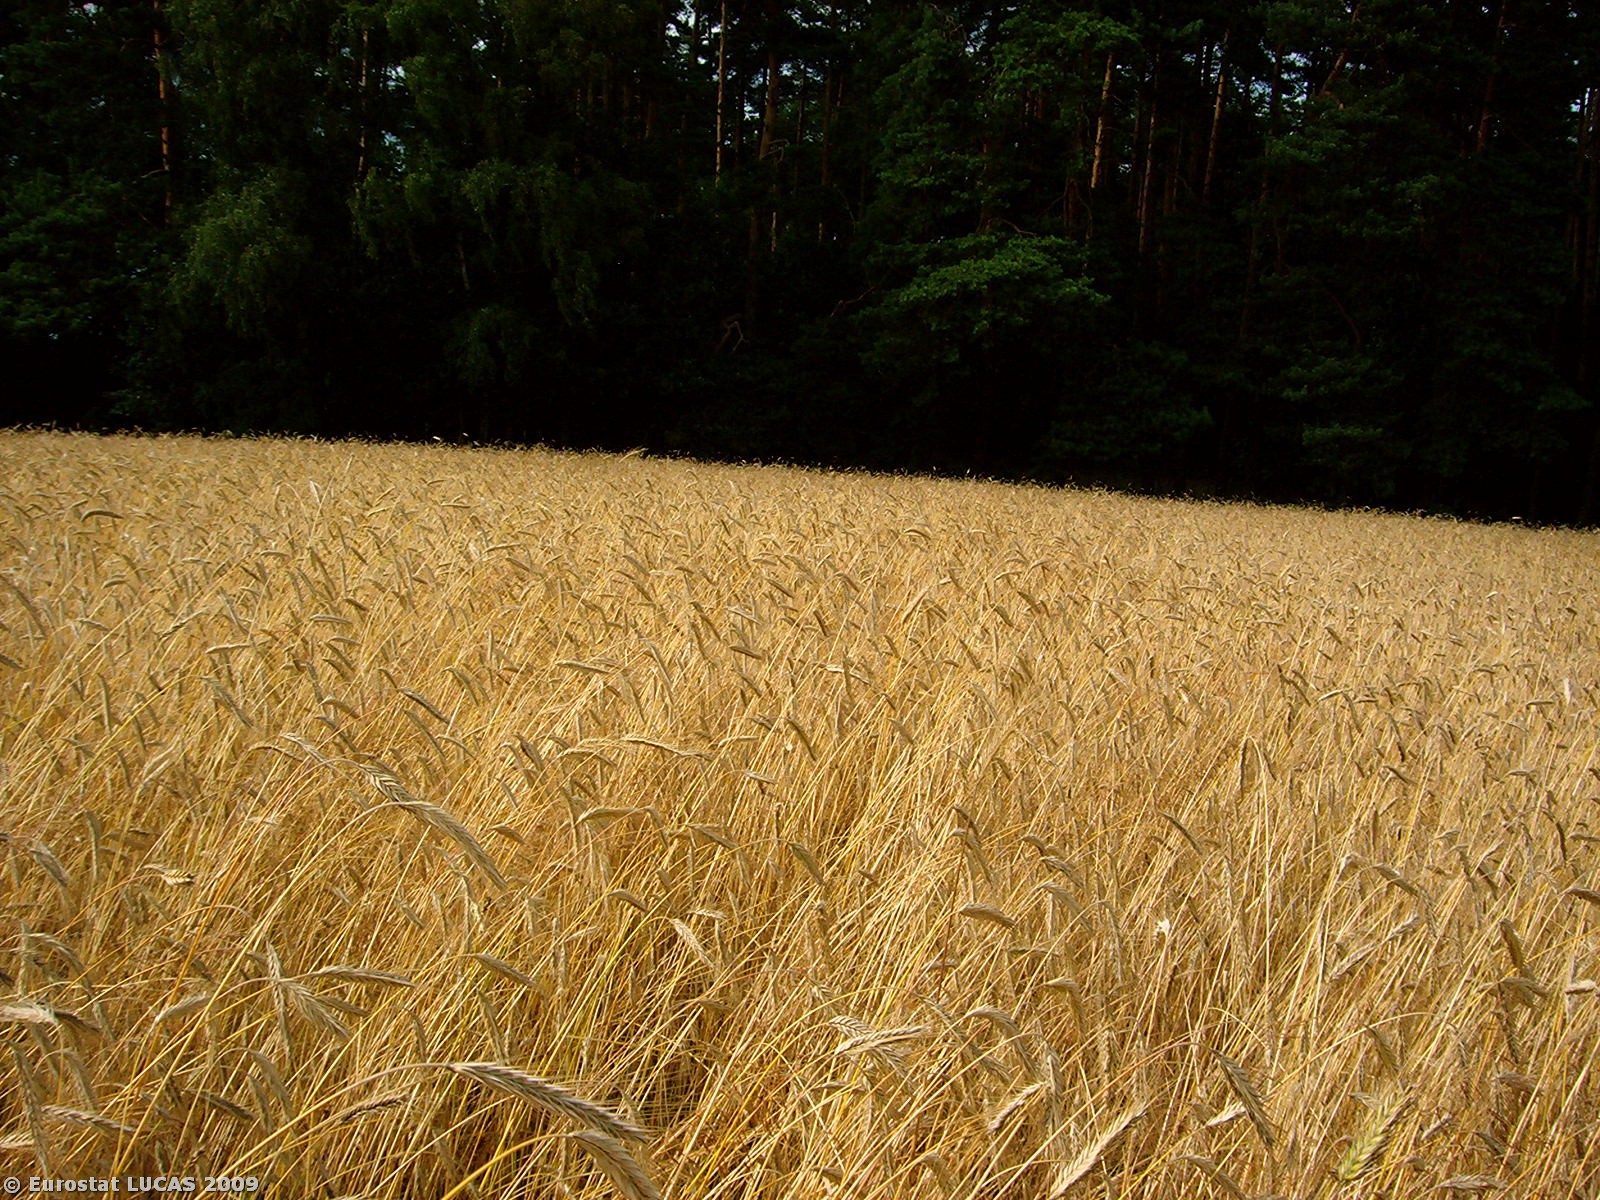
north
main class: Cropland
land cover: Triticale
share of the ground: 50 - 75 %
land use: Agriculture (excluding fallow land and kitchen gardens)
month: July
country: PL
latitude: 52.4605
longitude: 15.2279
